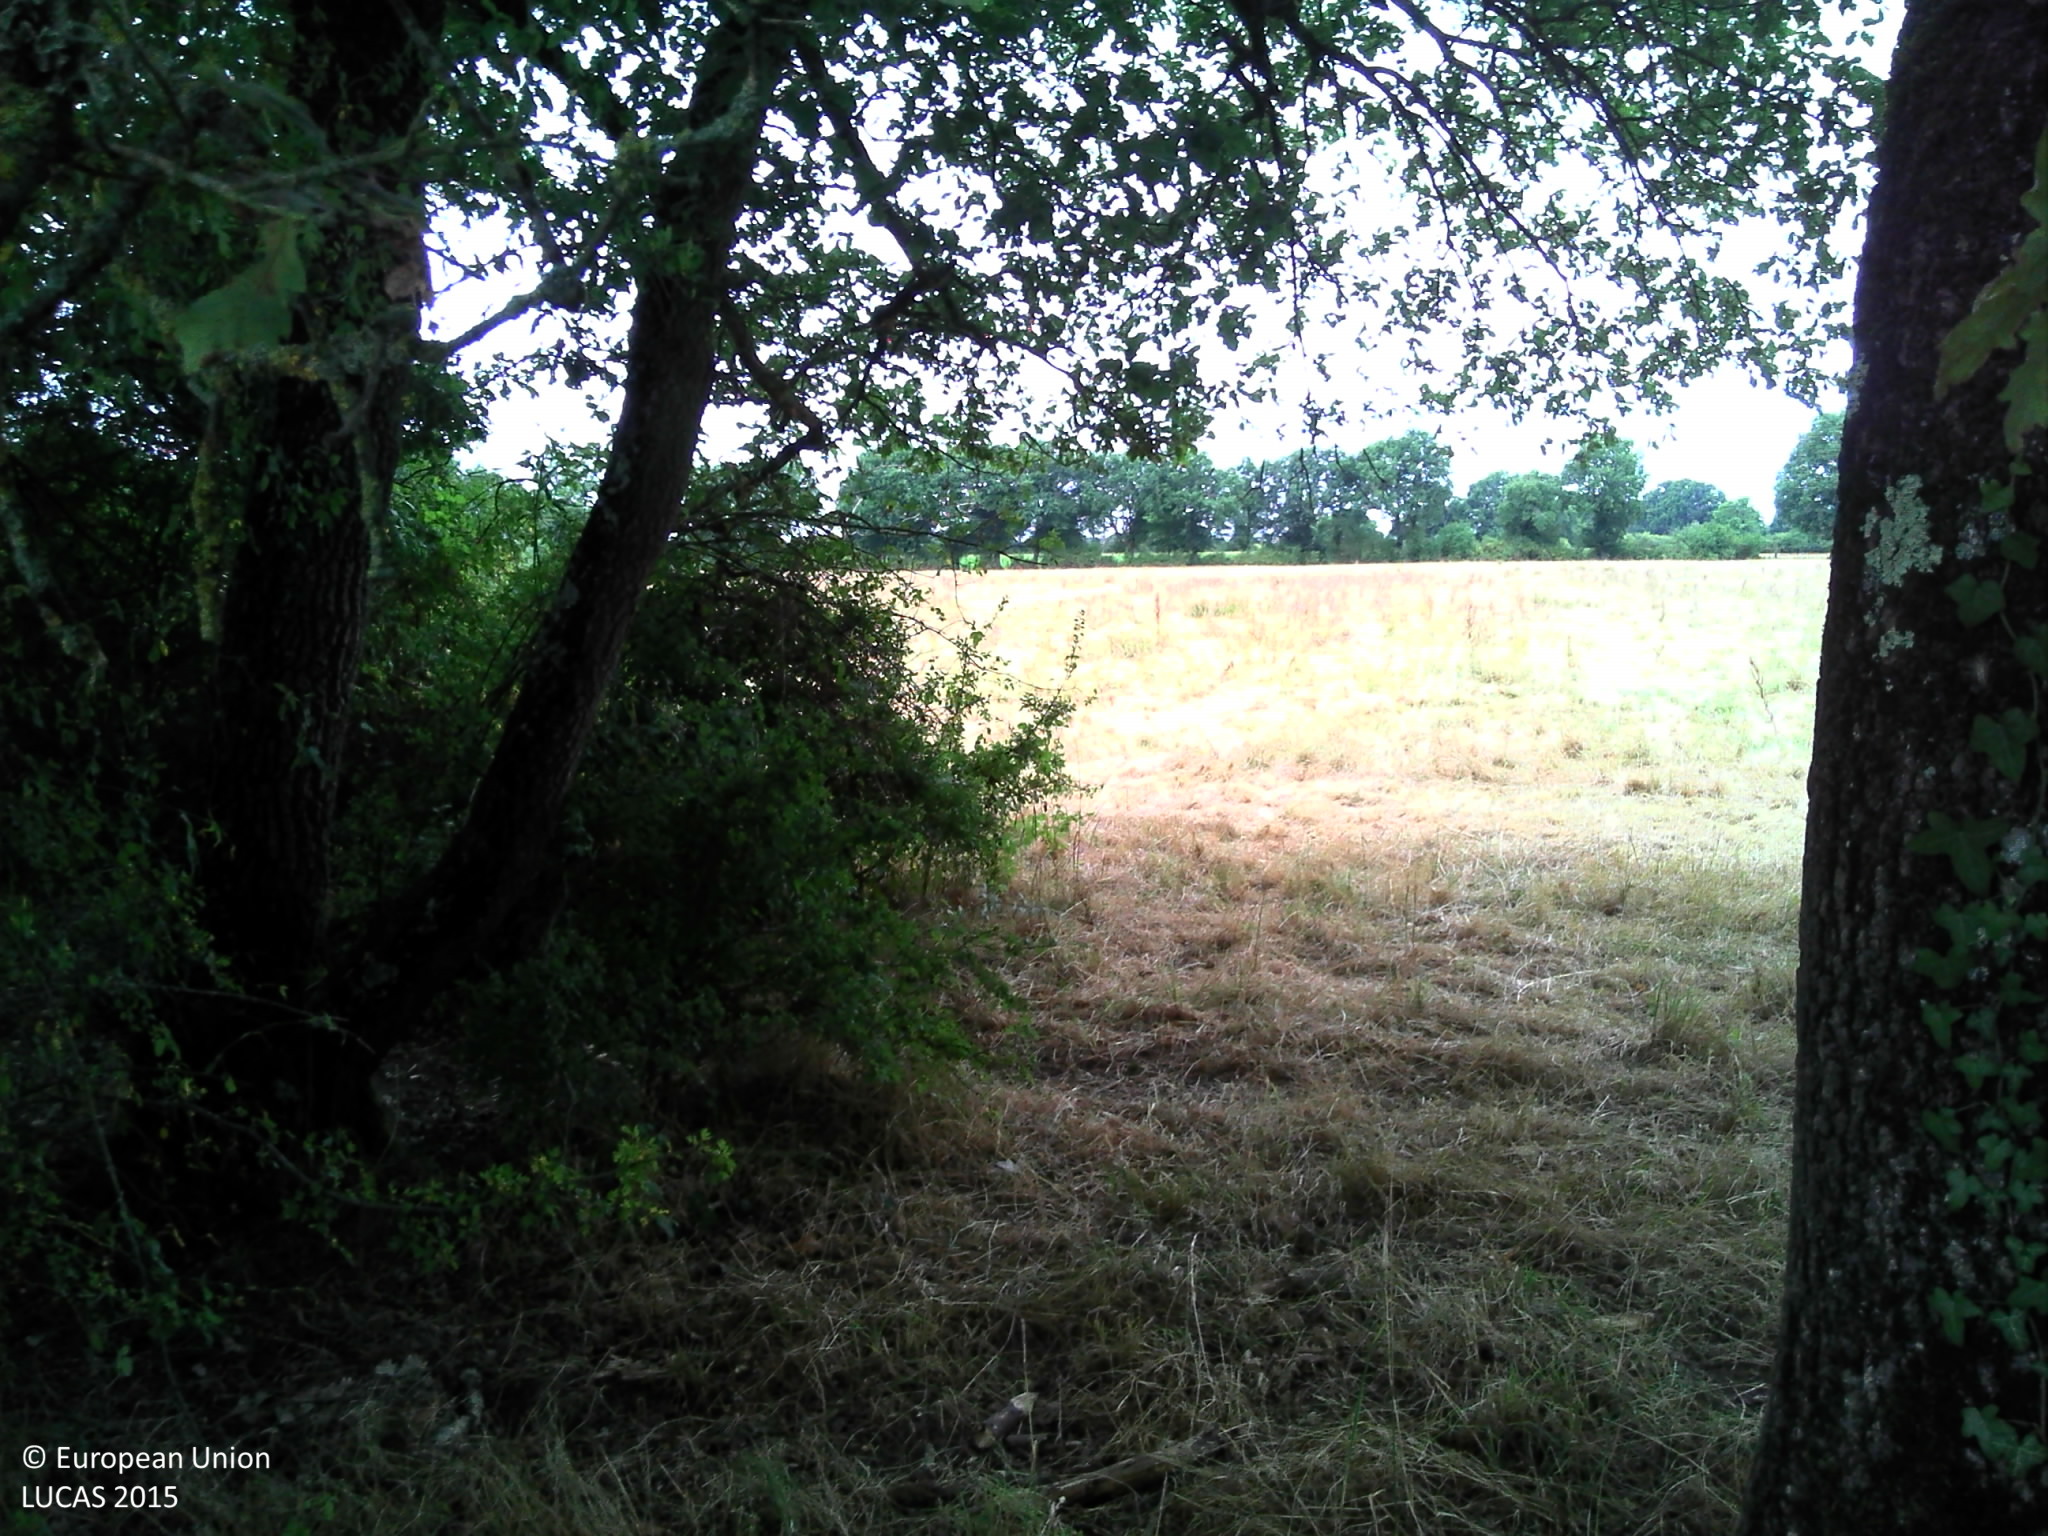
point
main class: Grassland
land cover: Grassland without tree/shrub cover
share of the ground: > 75 %
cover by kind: herbaceous plants 100 %
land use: Agriculture (excluding fallow land and kitchen gardens)
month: July
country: FR
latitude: 46.3322
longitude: 0.5658
